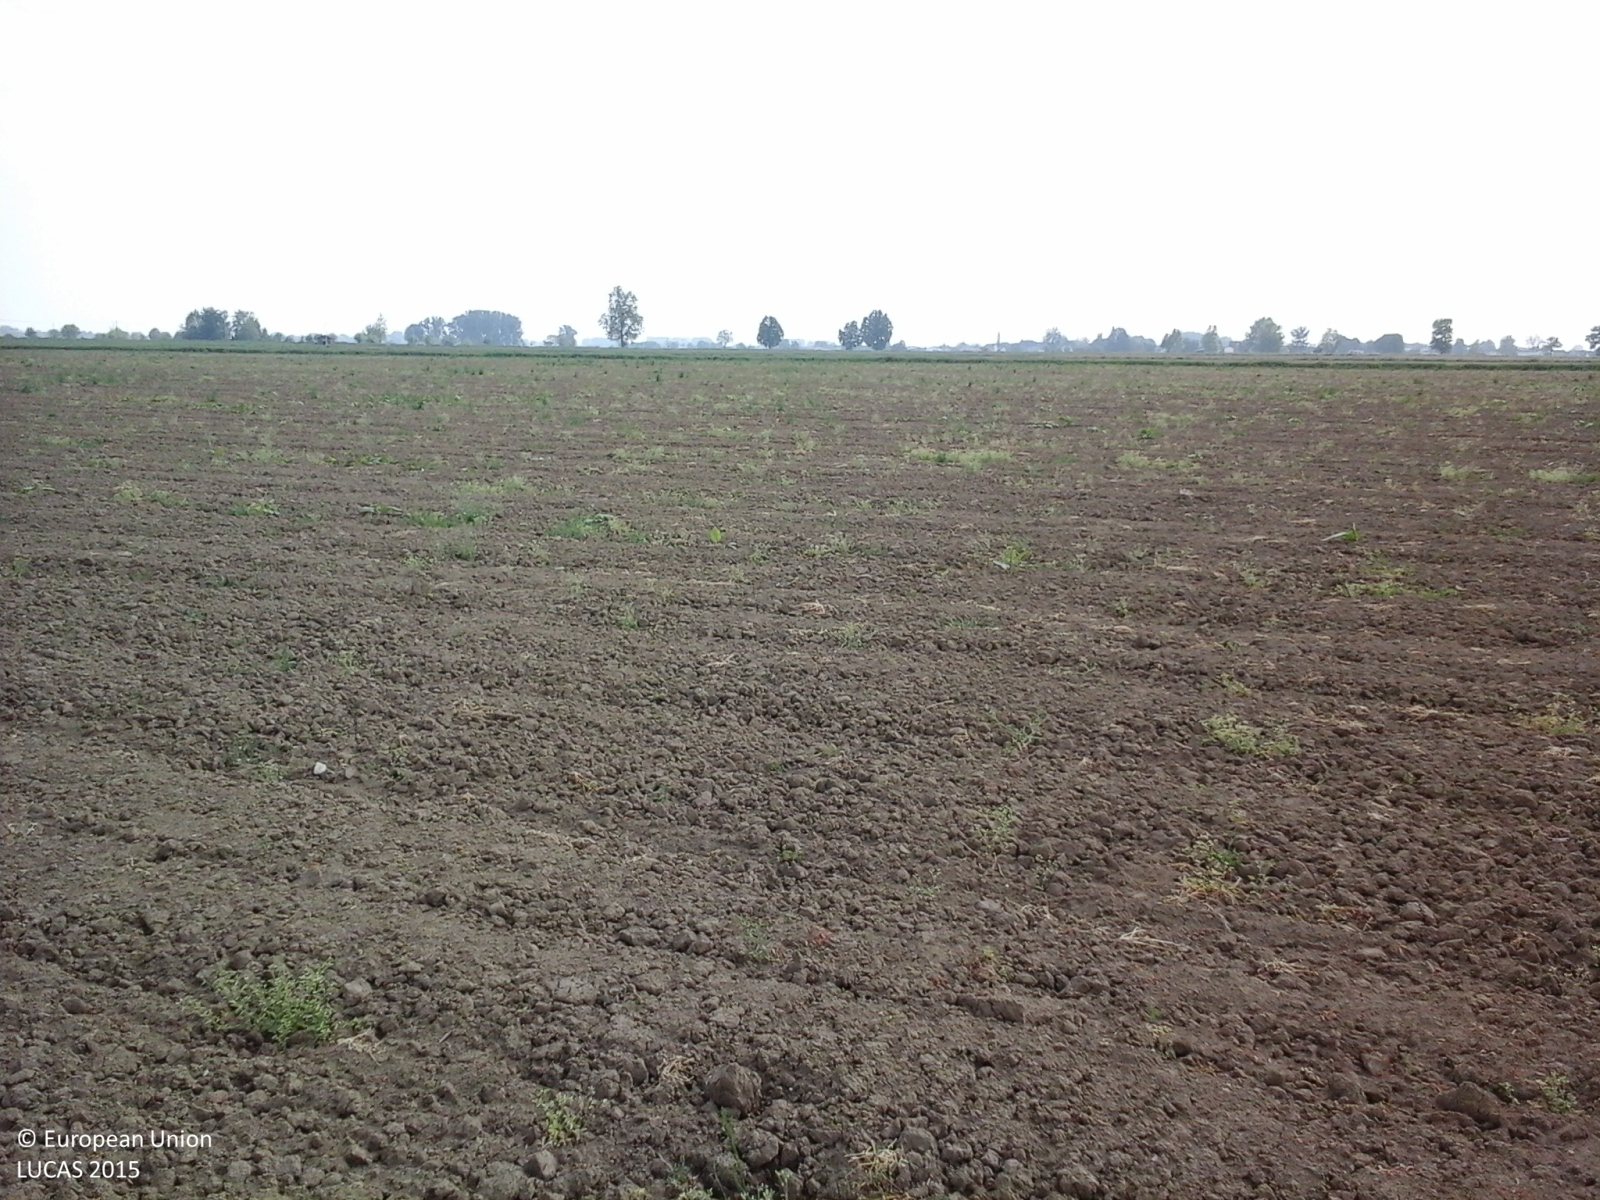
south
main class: Cropland
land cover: Maize
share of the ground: < 10 %
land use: Agriculture (excluding fallow land and kitchen gardens)
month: May
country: IT
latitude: 45.0715
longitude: 10.2662
